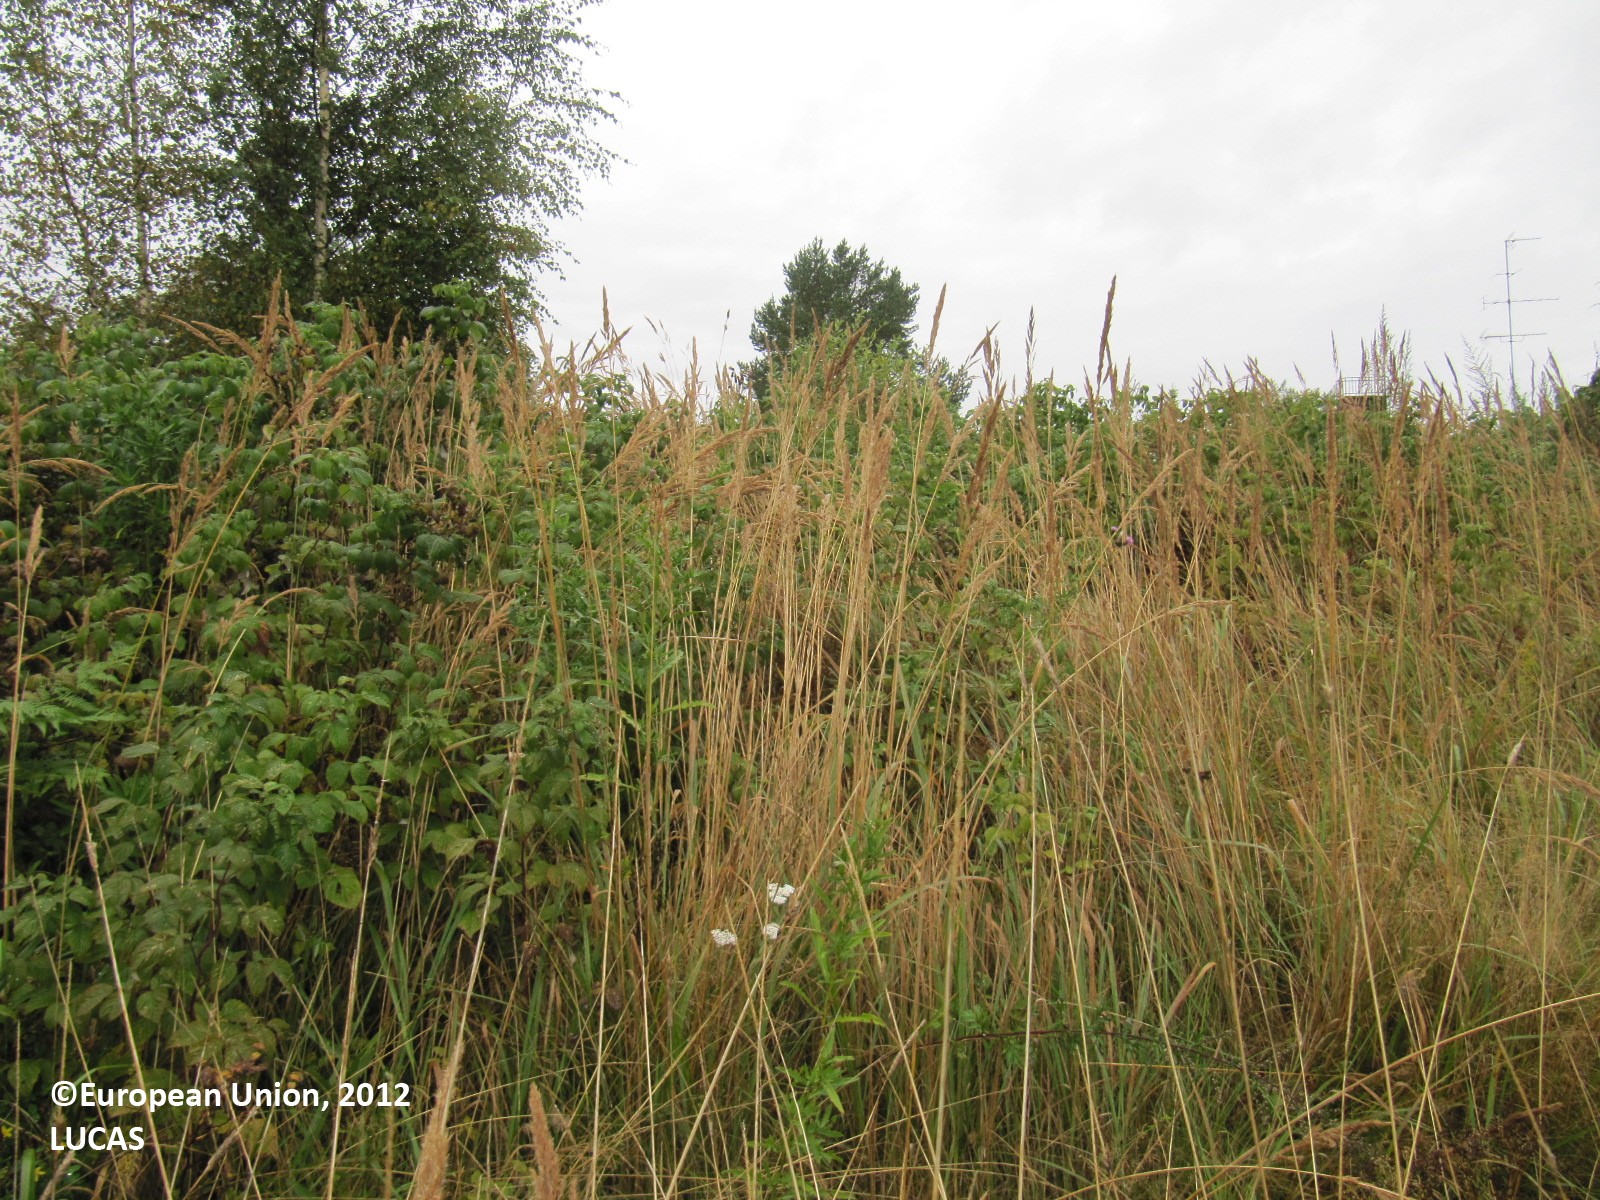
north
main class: Cropland
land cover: Barley
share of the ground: > 75 %
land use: Agriculture (excluding fallow land and kitchen gardens)
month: September
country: FI
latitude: 60.0583
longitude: 24.0566
